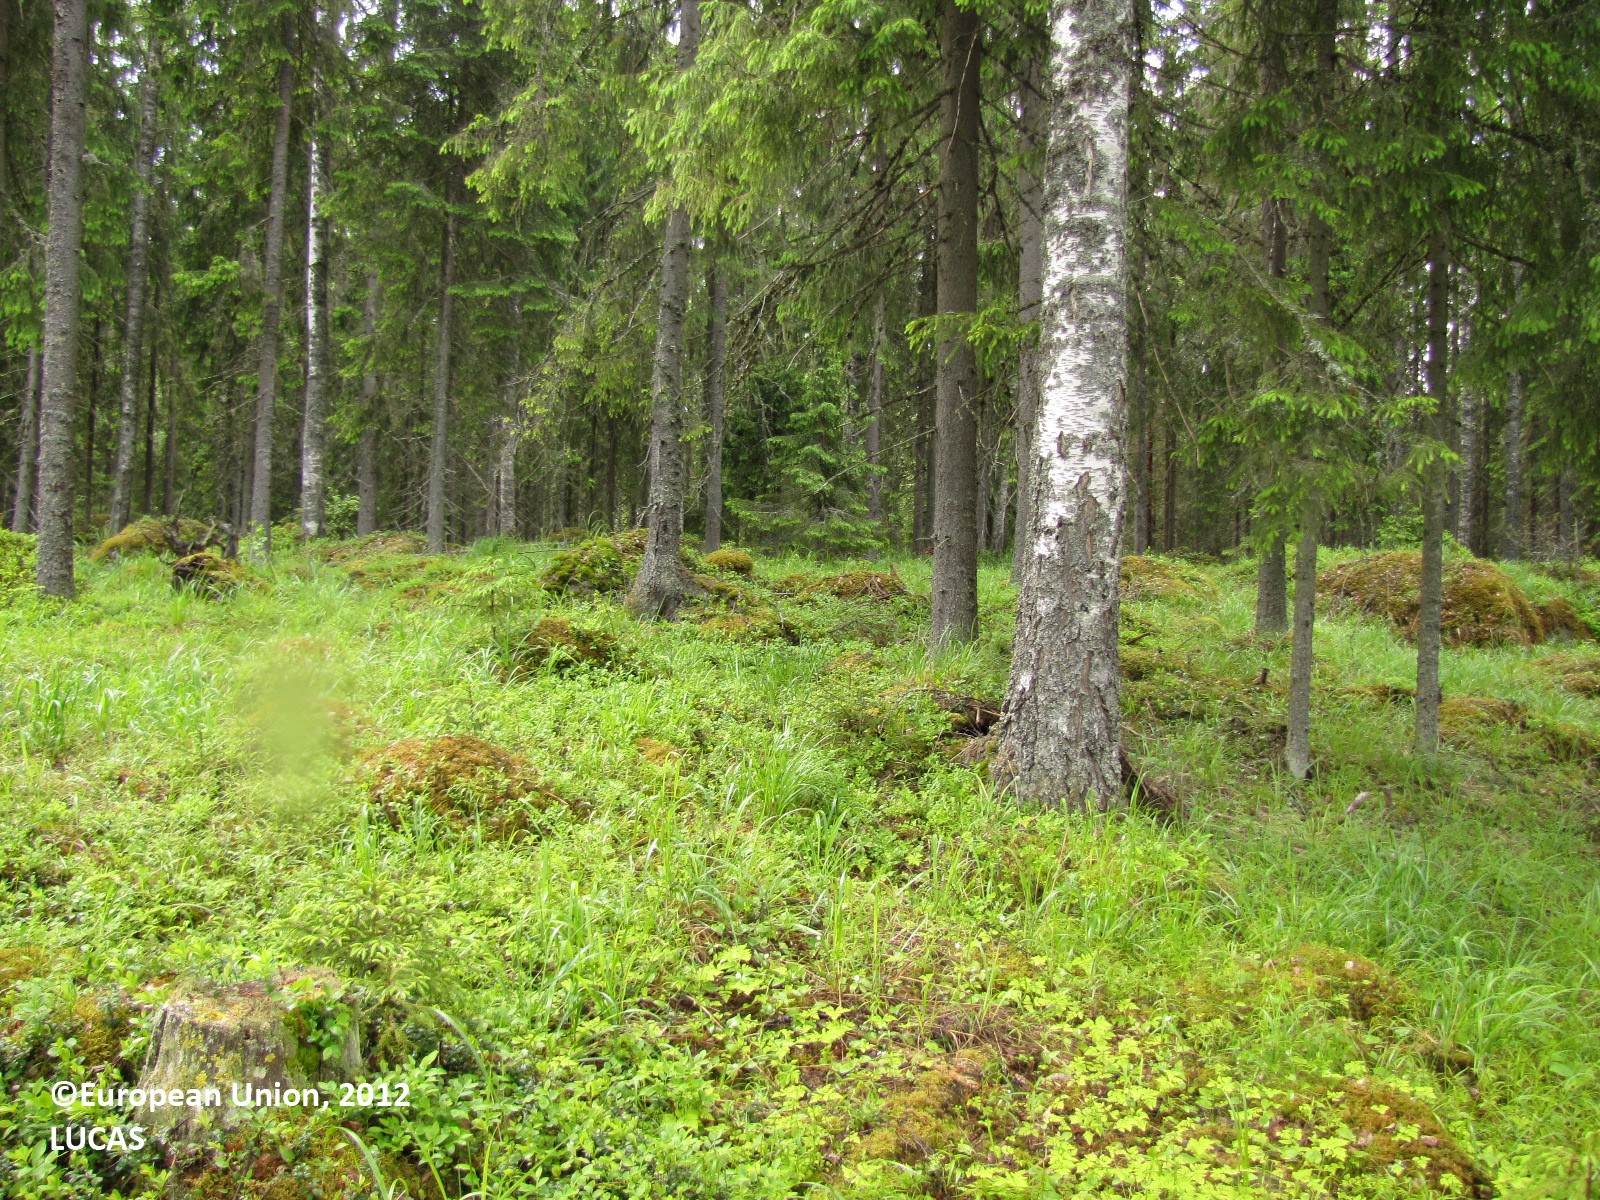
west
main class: Woodland
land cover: Spruce dominated coniferous woodland
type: boreal forest
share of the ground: > 75 %
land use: Forestry
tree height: > 5 m
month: June
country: FI
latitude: 61.2615
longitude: 23.5621
